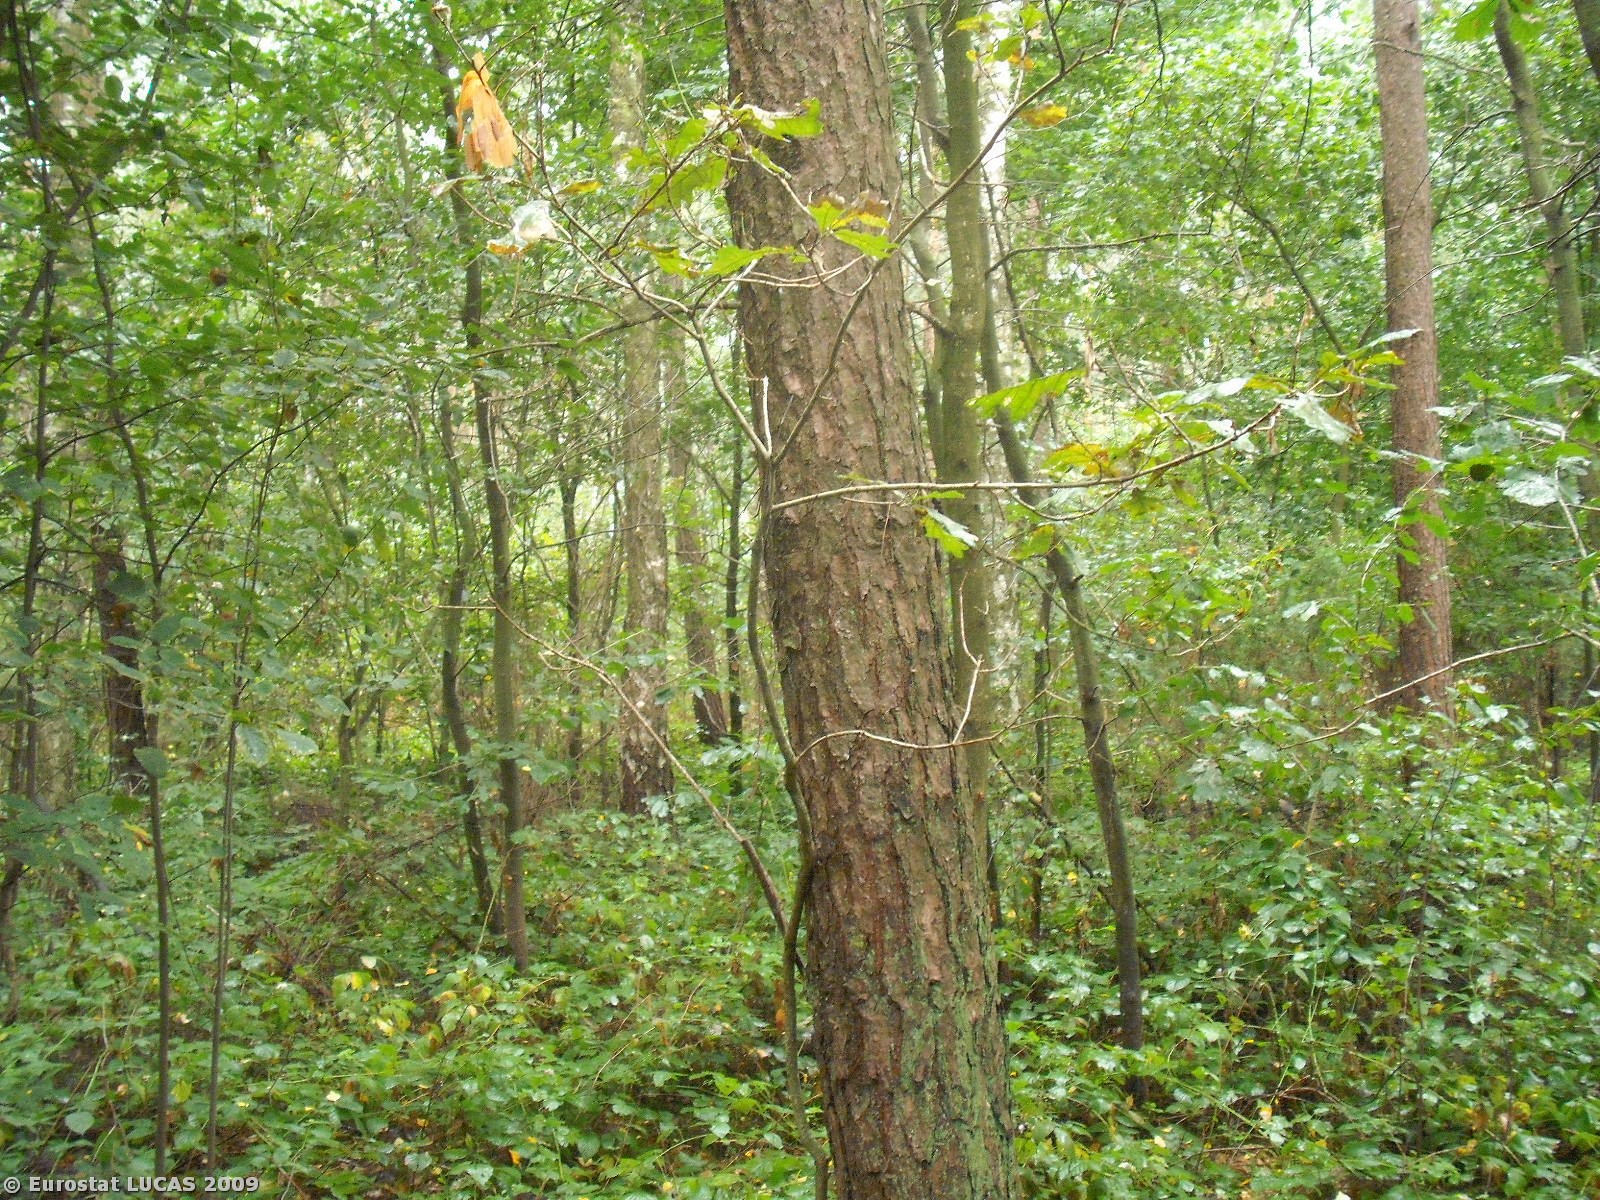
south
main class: Woodland
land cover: Mixed woodland
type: hemiboreal forest and nemoral coniferous forest and mixed broadleaved-coniferous forest
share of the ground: > 75 %
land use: Forestry
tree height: > 5 m
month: September
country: PL
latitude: 51.7175
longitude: 22.1177
